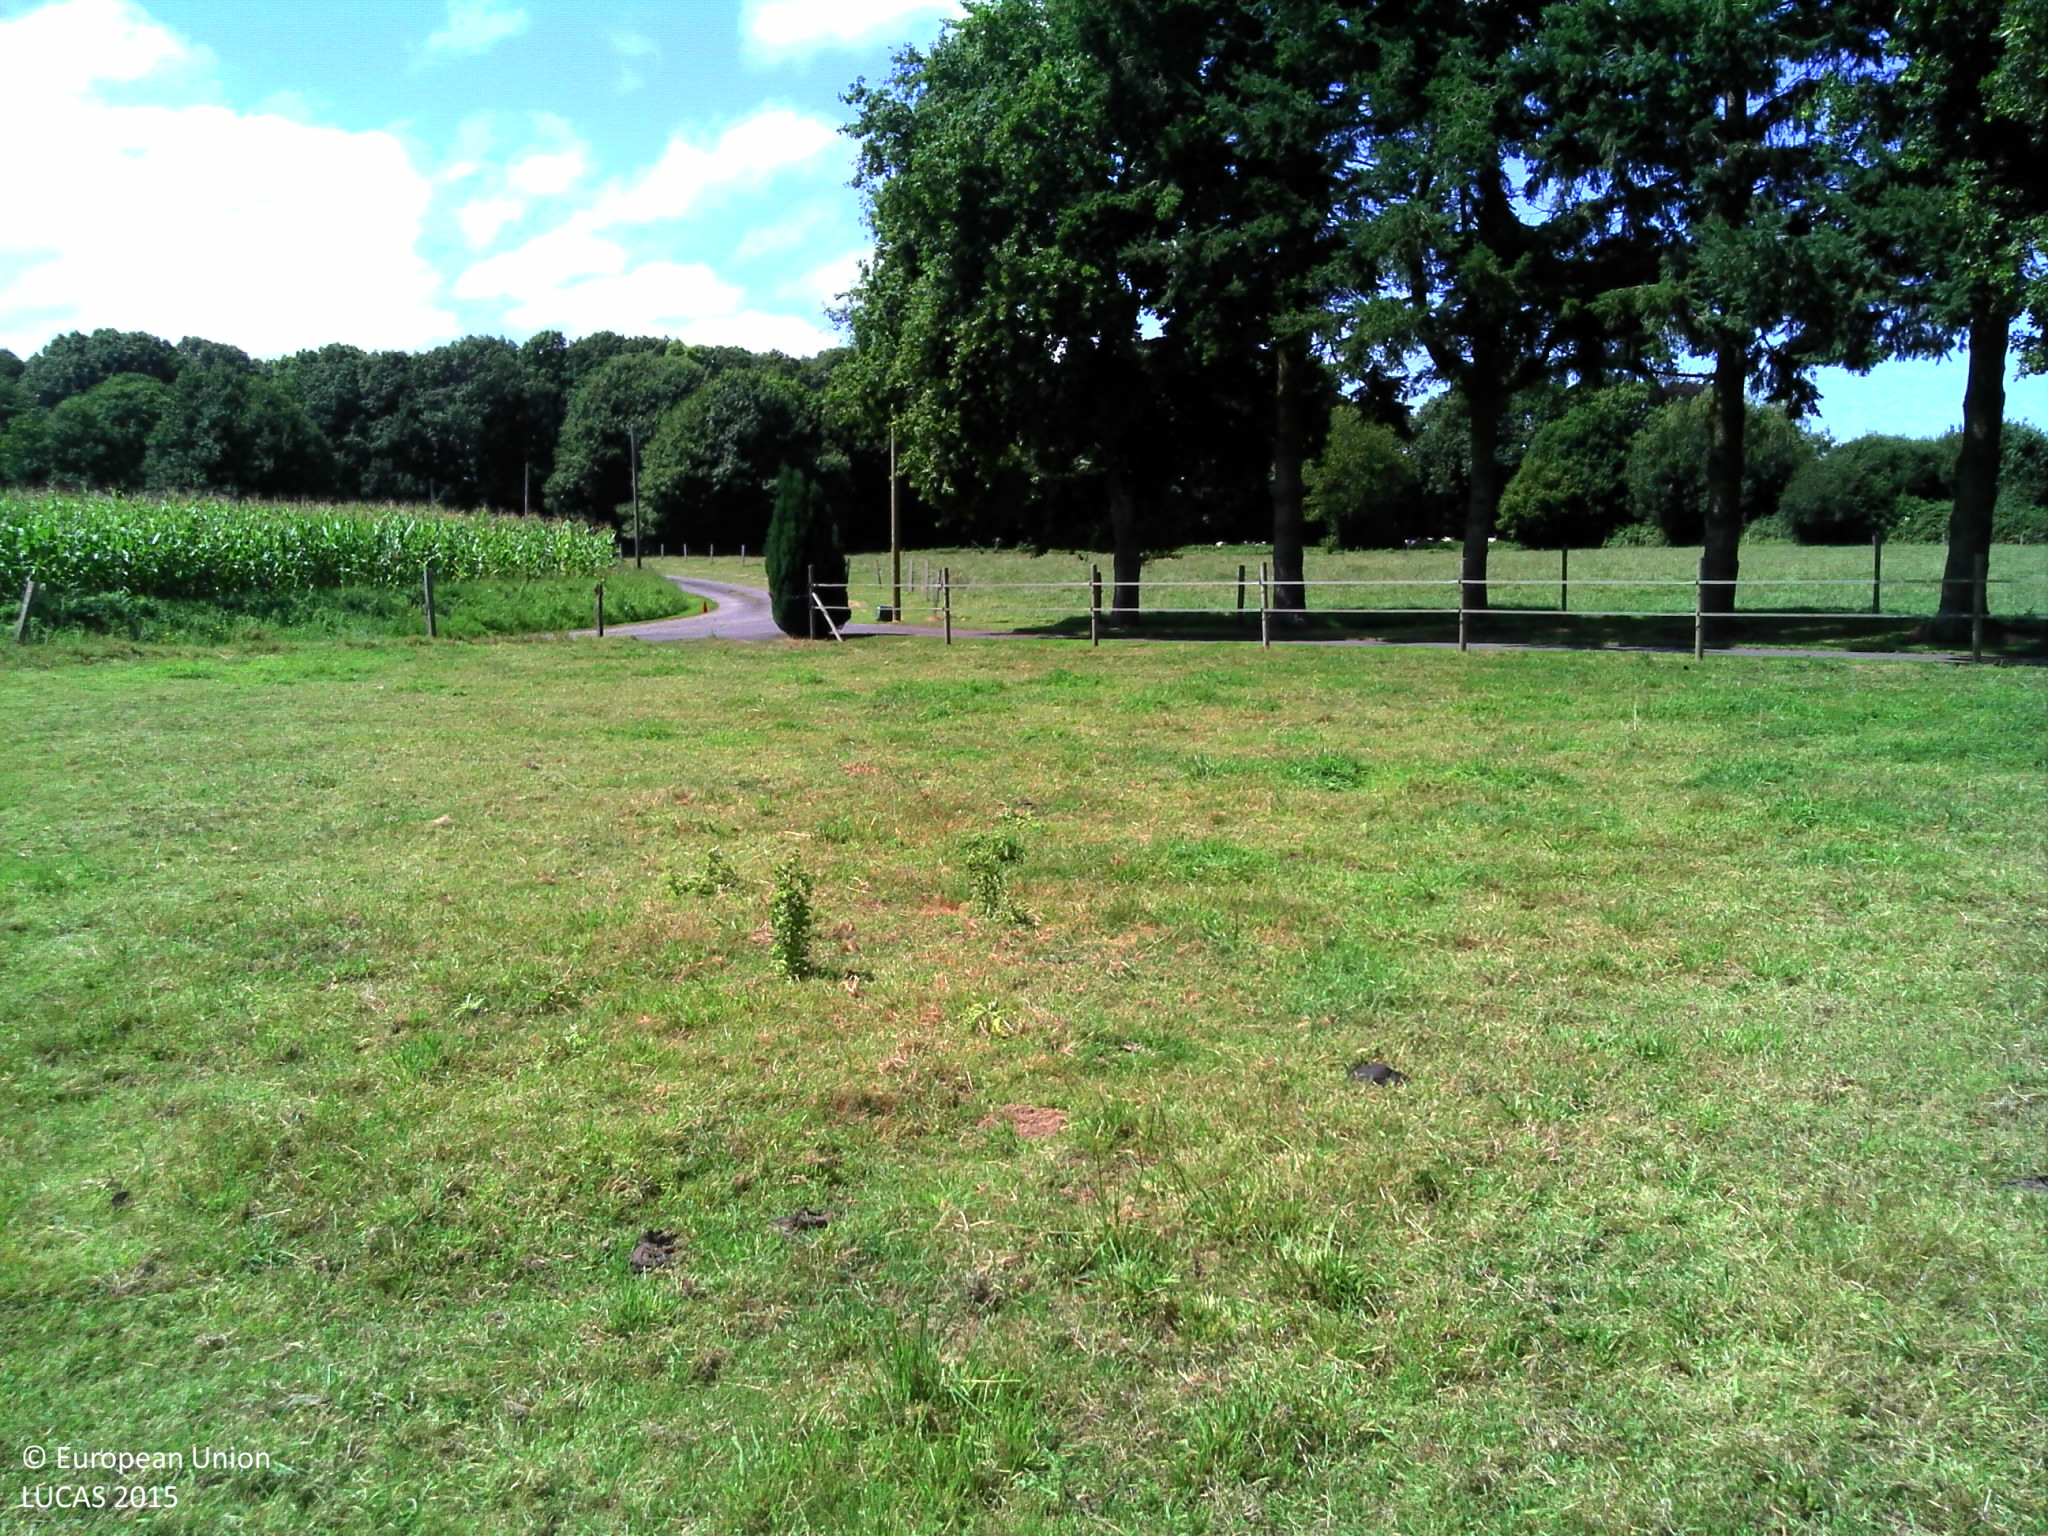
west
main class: Grassland
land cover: Grassland without tree/shrub cover
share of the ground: > 75 %
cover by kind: herbaceous plants 100 %
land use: Agriculture (excluding fallow land and kitchen gardens)
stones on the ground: < 10 %
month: August
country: FR
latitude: 48.5664
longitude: -1.3059
